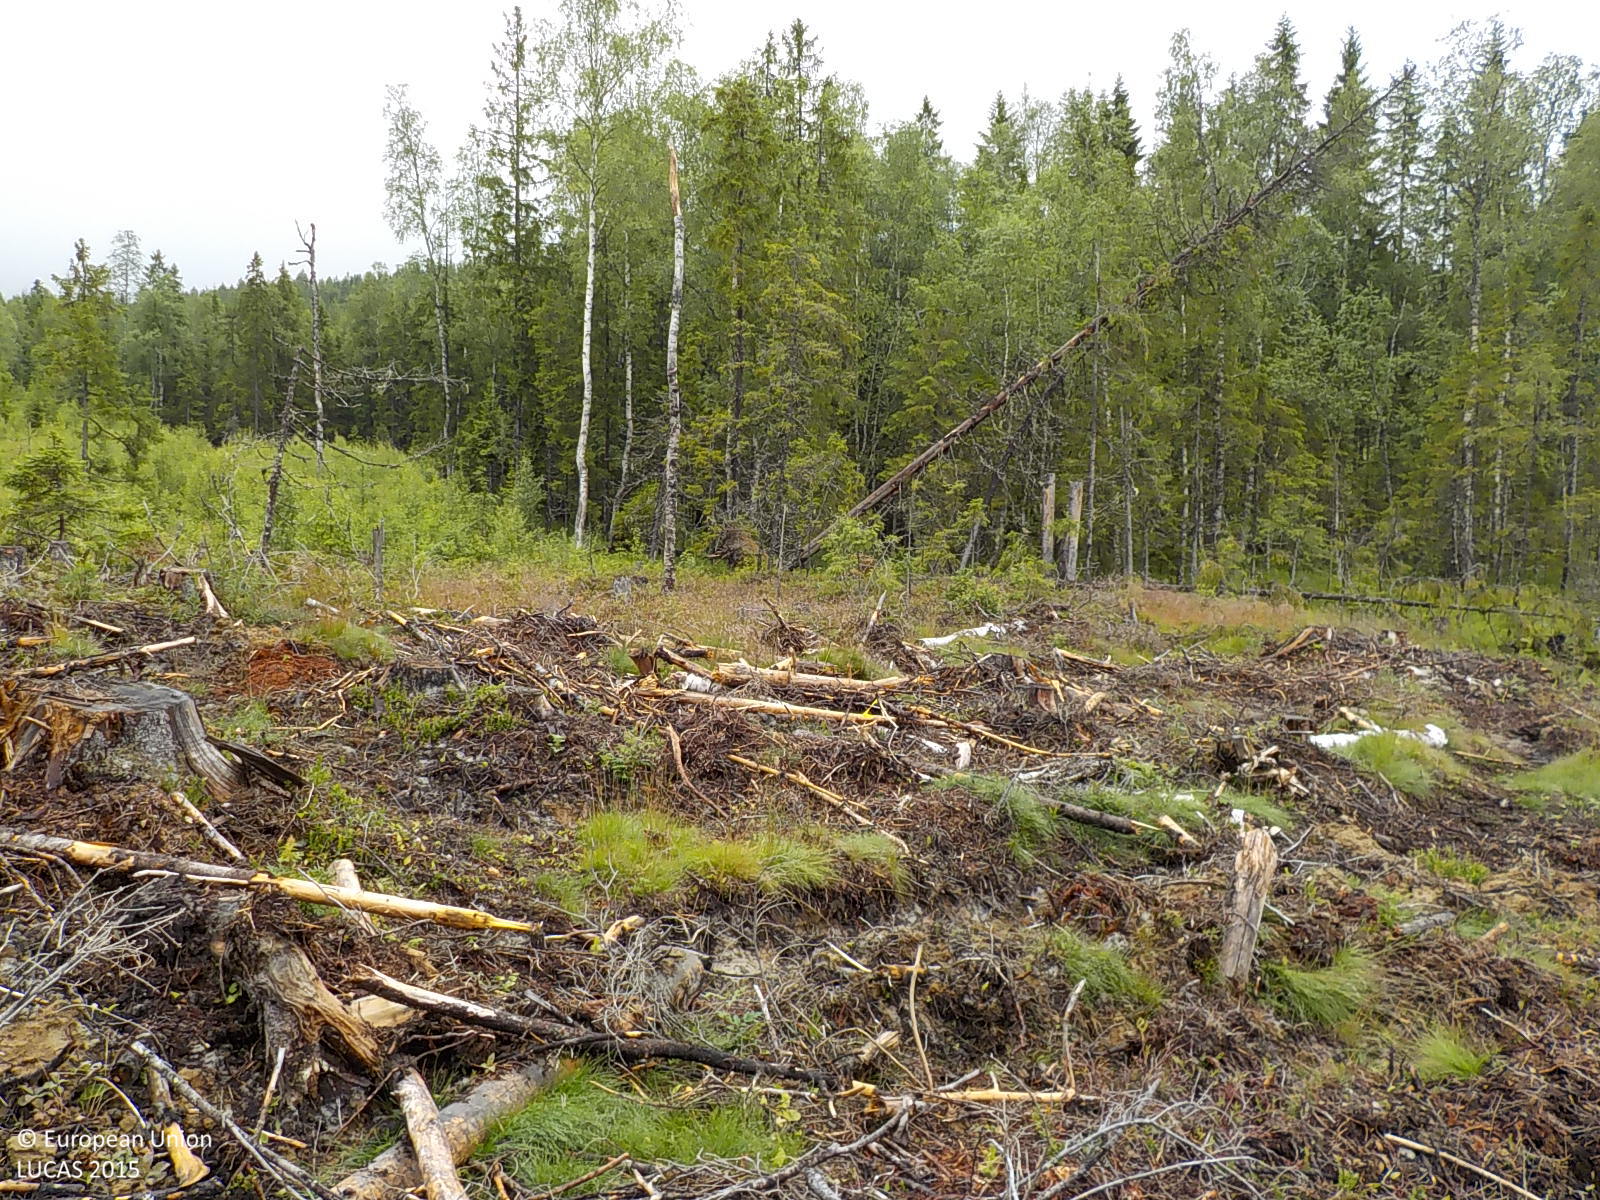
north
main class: Grassland
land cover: Grassland with sparse tree/shrub cover
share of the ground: 50 - 75 %
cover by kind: herbaceous plants 55 %, coniferous forest trees 5 %, shrubs 5 %, unconsolidated bare surface 5 %
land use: Forestry
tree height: < 5 m
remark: Clear cut
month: July
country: SE
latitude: 63.1437
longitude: 18.3312
